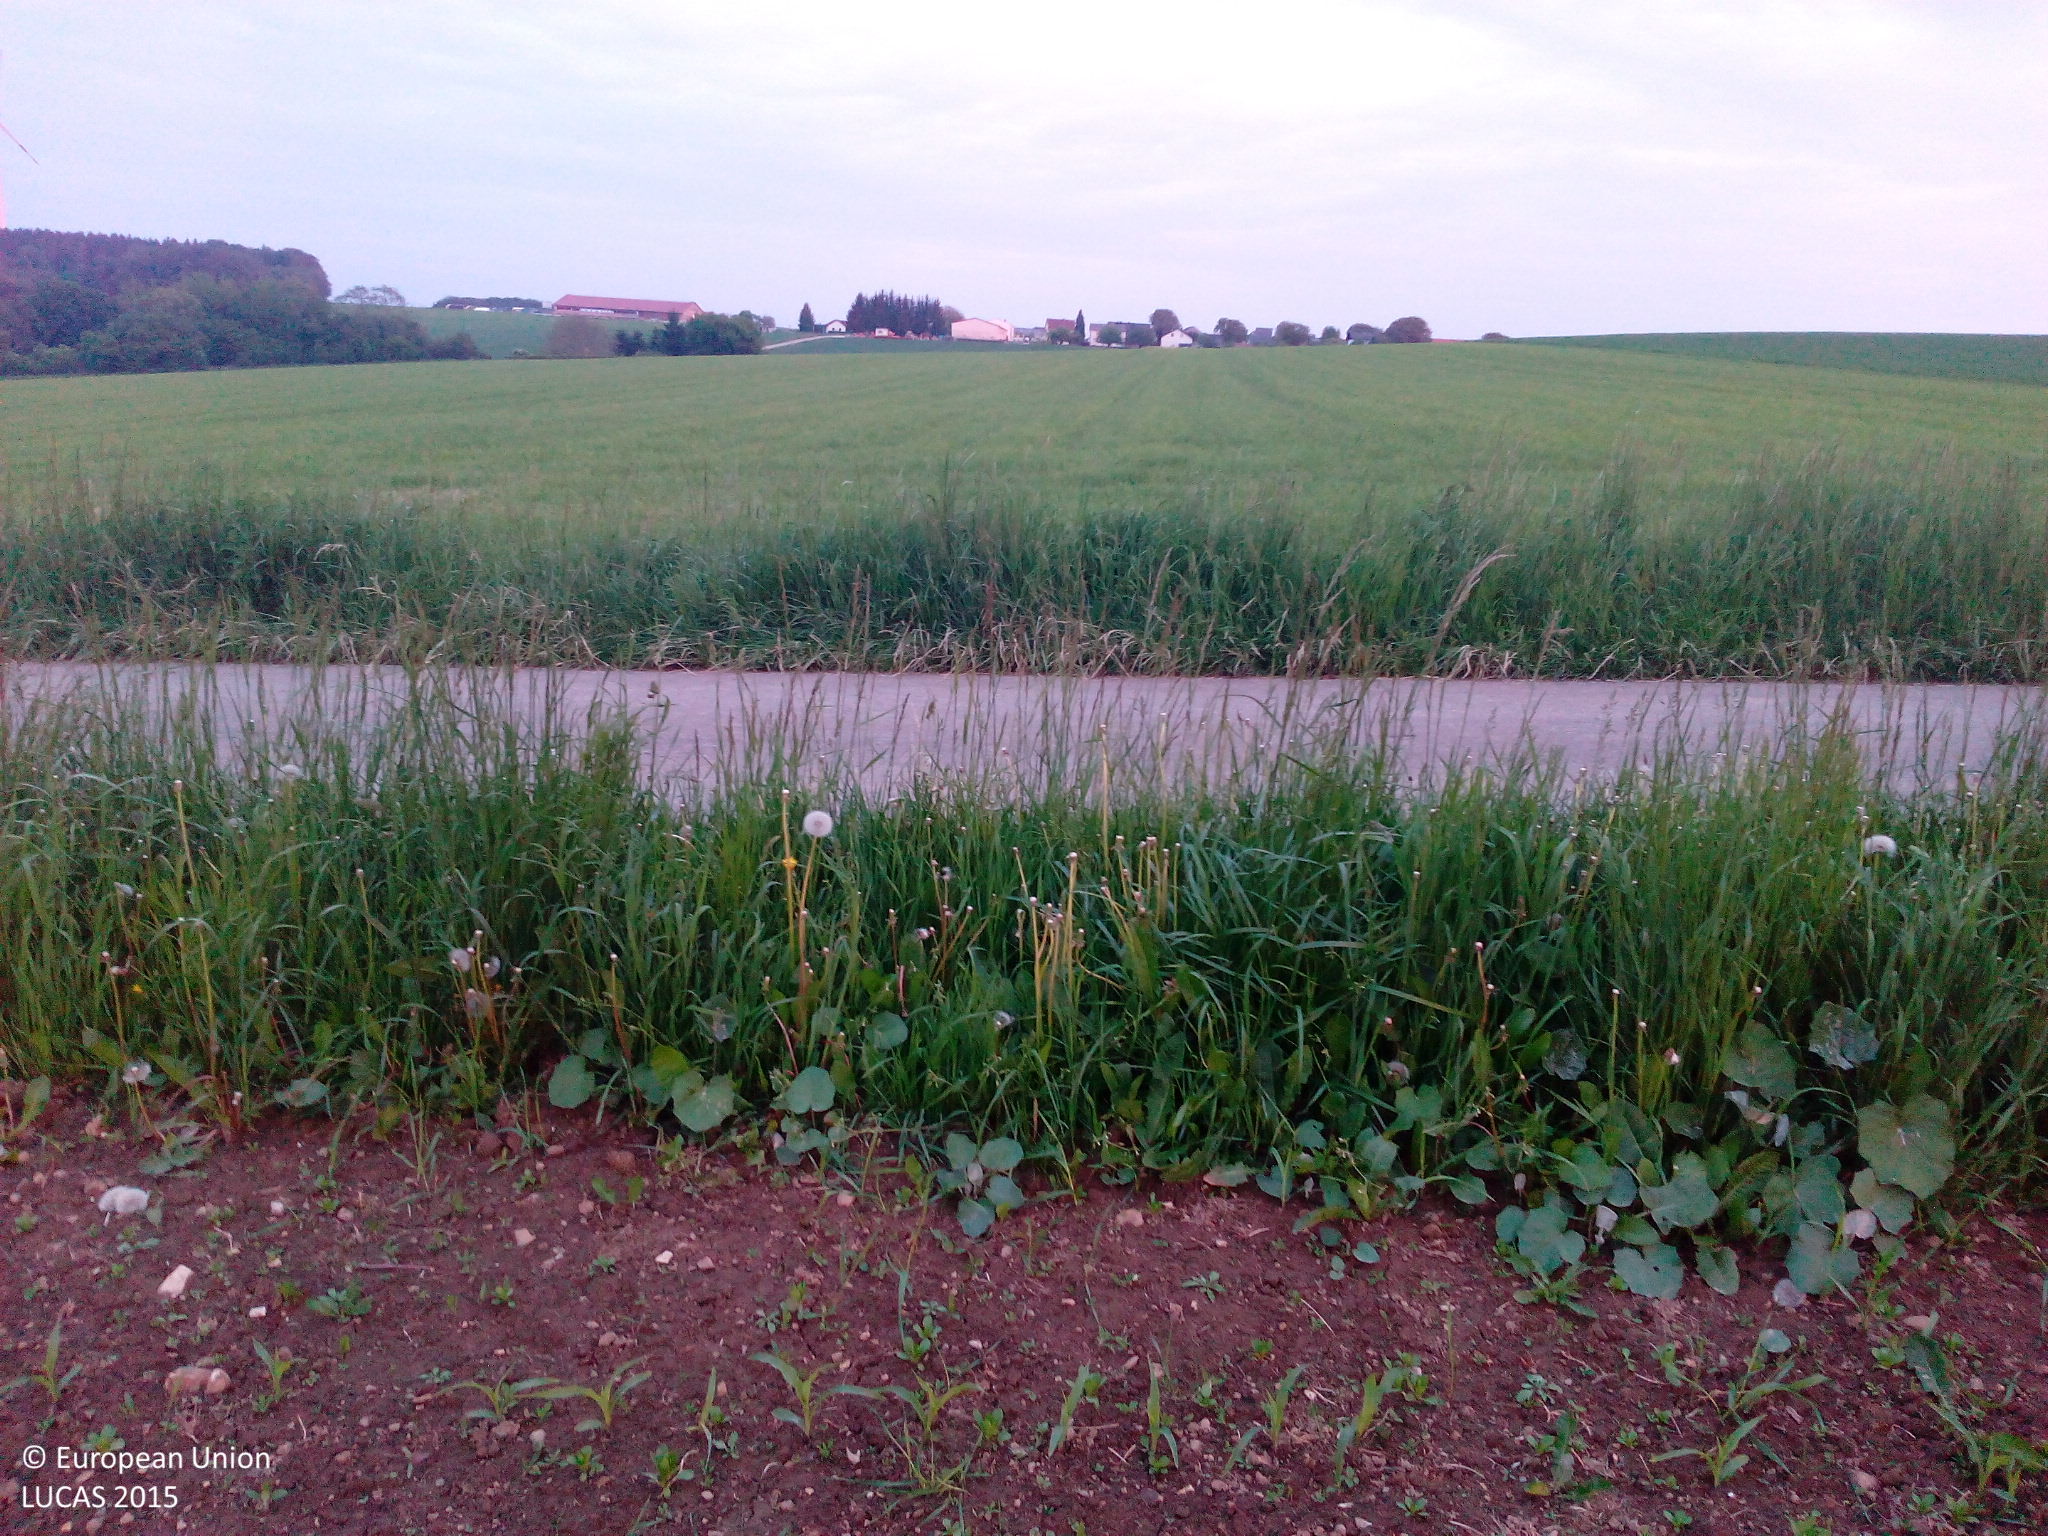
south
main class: Cropland
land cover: Maize
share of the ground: < 10 %
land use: Agriculture (excluding fallow land and kitchen gardens)
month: May
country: DE
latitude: 48.9502
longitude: 11.5698
